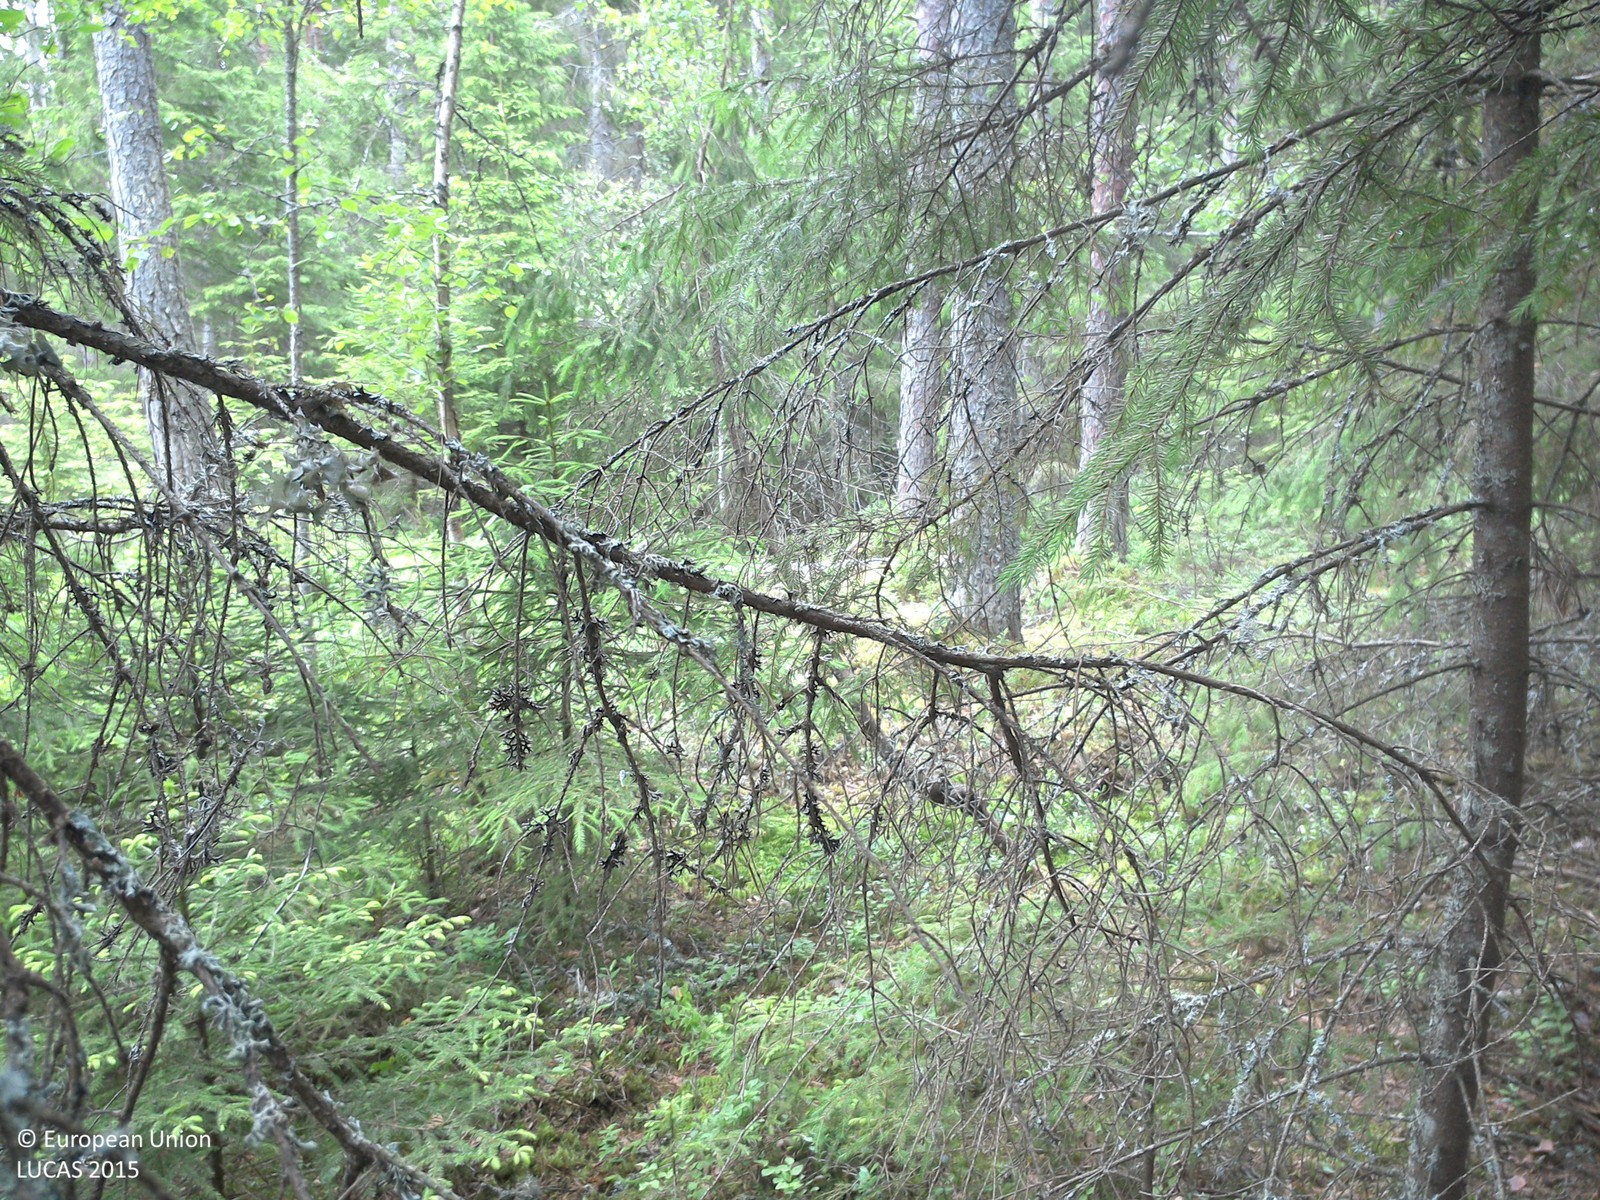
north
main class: Woodland
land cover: Spruce dominated coniferous woodland
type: boreal forest
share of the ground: > 75 %
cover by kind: coniferous forest trees 75 %, lichens and mosses 25 %
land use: Forestry
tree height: > 5 m
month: June
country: SE
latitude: 58.2471
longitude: 15.6001
